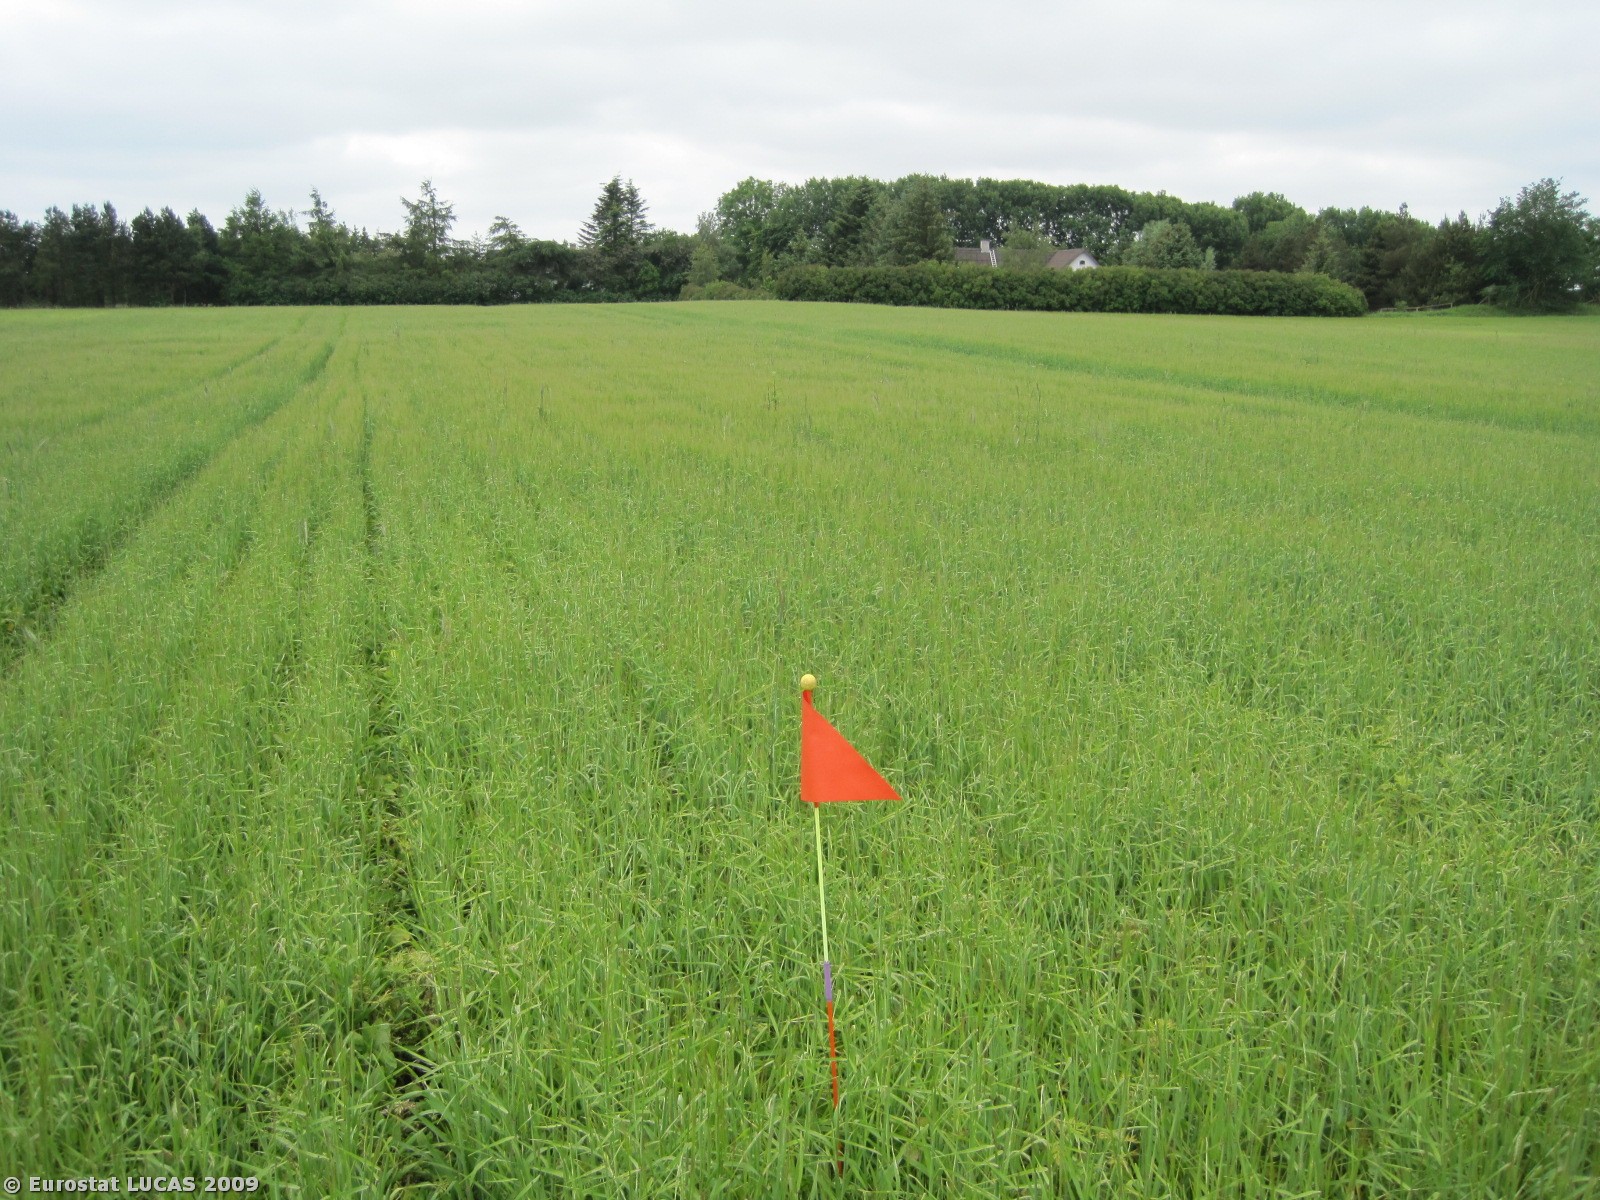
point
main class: Cropland
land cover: Barley
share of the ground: > 75 %
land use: Agriculture (excluding fallow land and kitchen gardens)
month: June
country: DK
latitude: 57.1944
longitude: 10.0826
